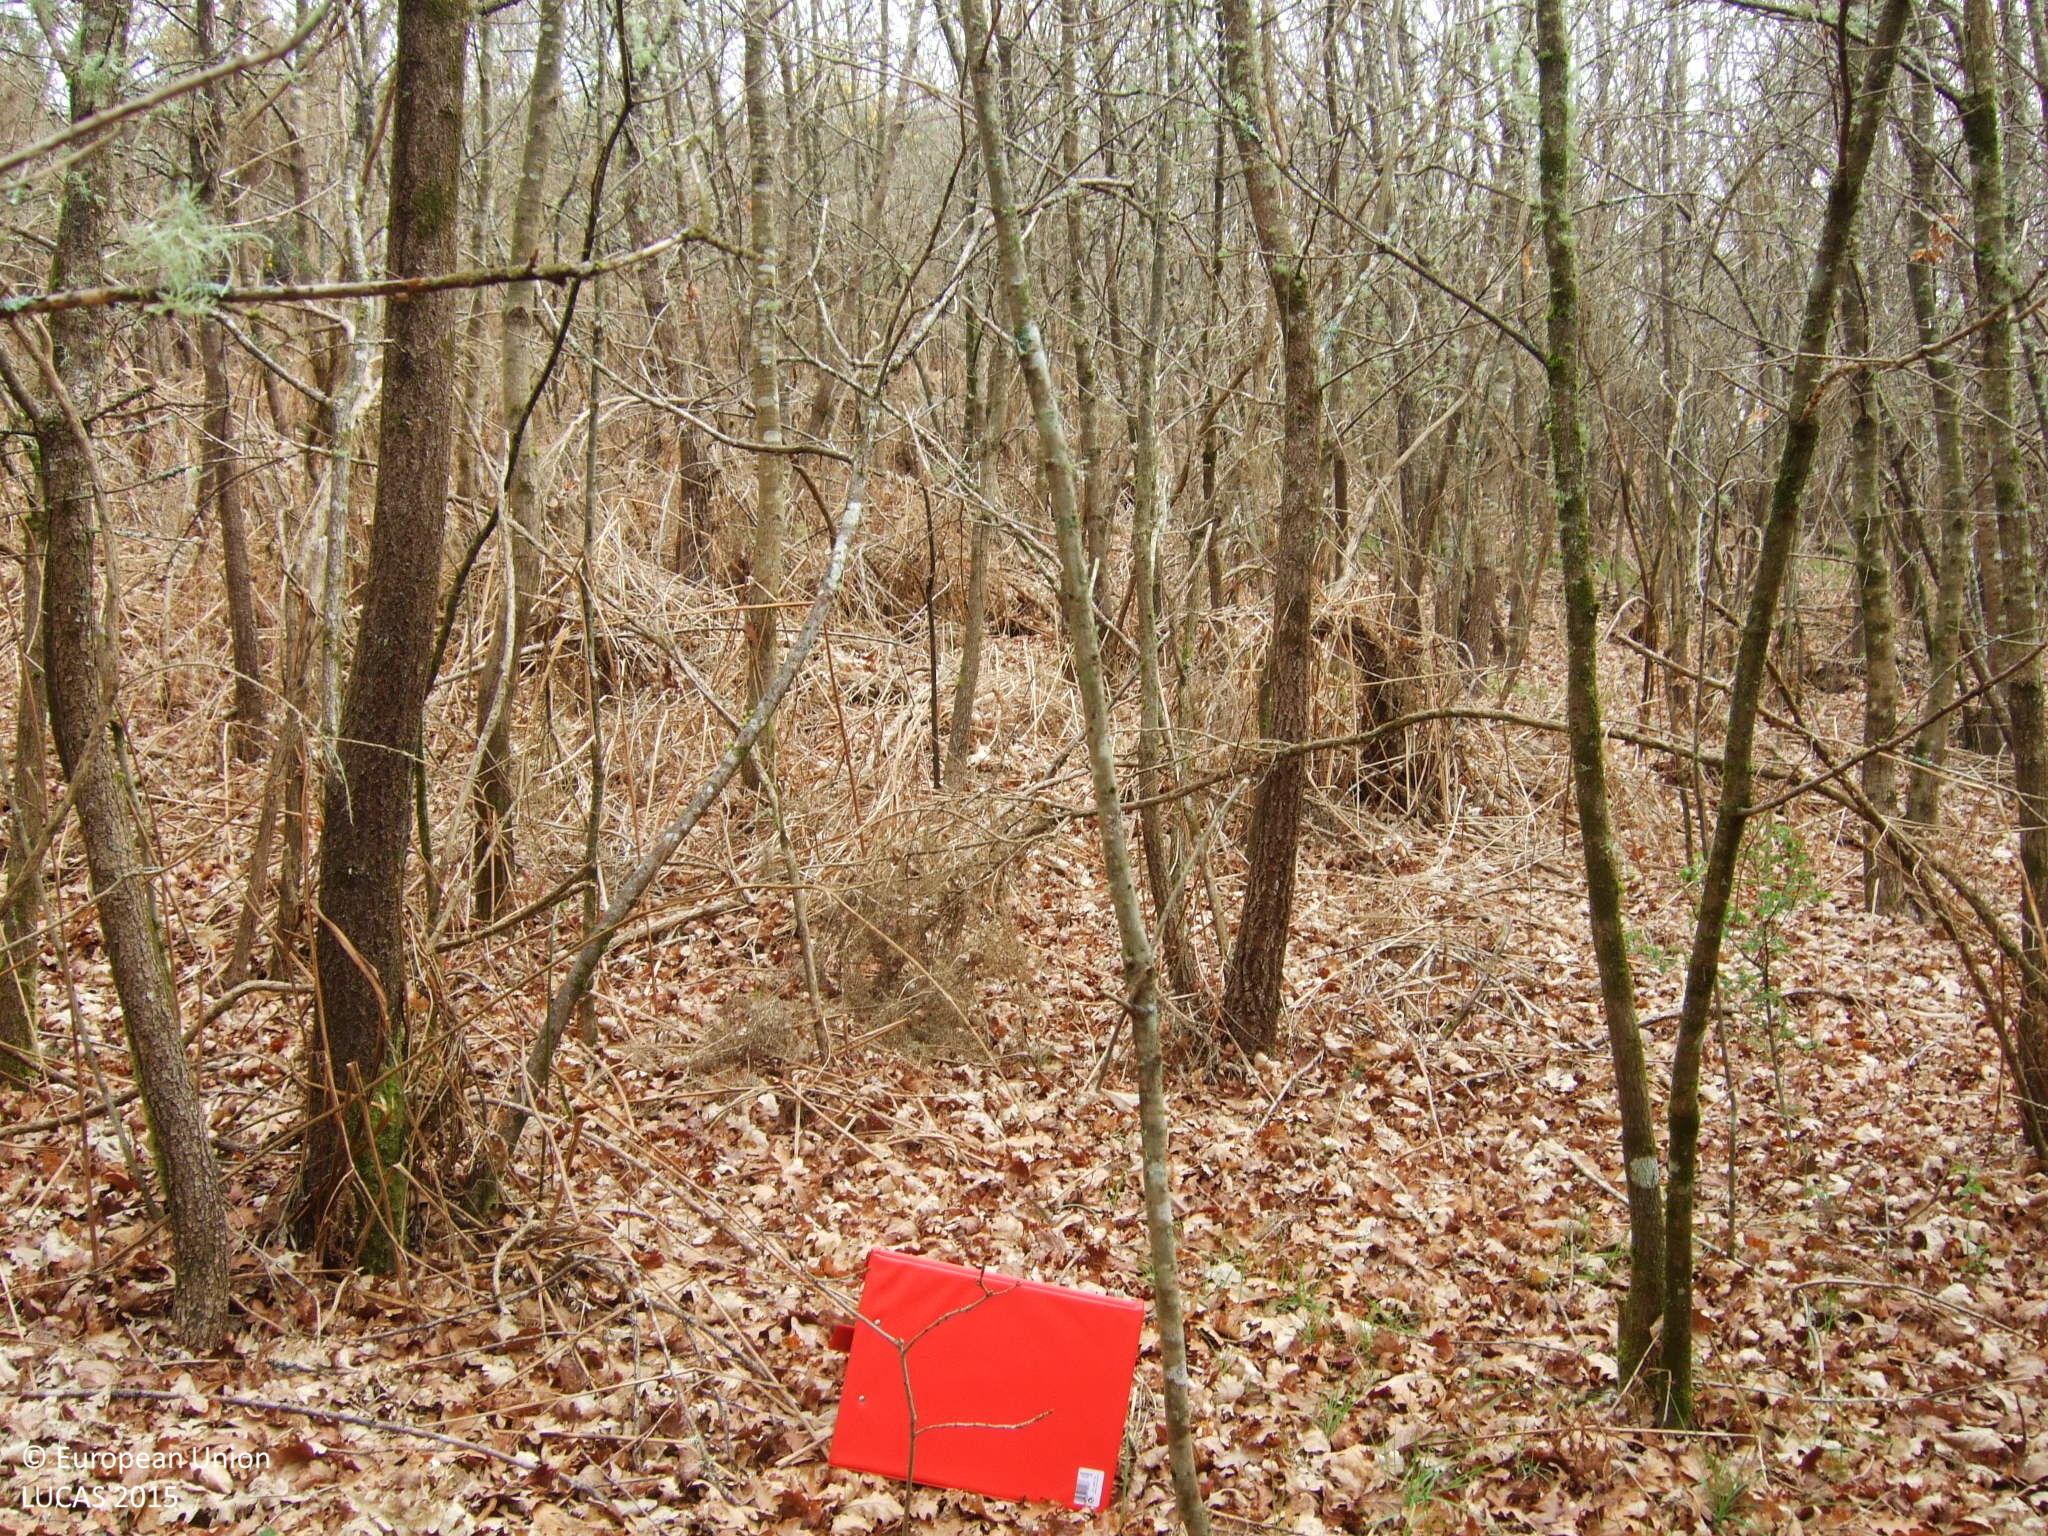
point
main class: Woodland
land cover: Broadleaved woodland
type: acidophilous oak and oak-birch forest
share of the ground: 50 - 75 %
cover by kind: broadleaved forest trees 70 %, shrubs 30 %
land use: Semi-natural and natural areas not in use
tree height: > 5 m
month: April
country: ES
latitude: 42.7750
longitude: -7.8160
